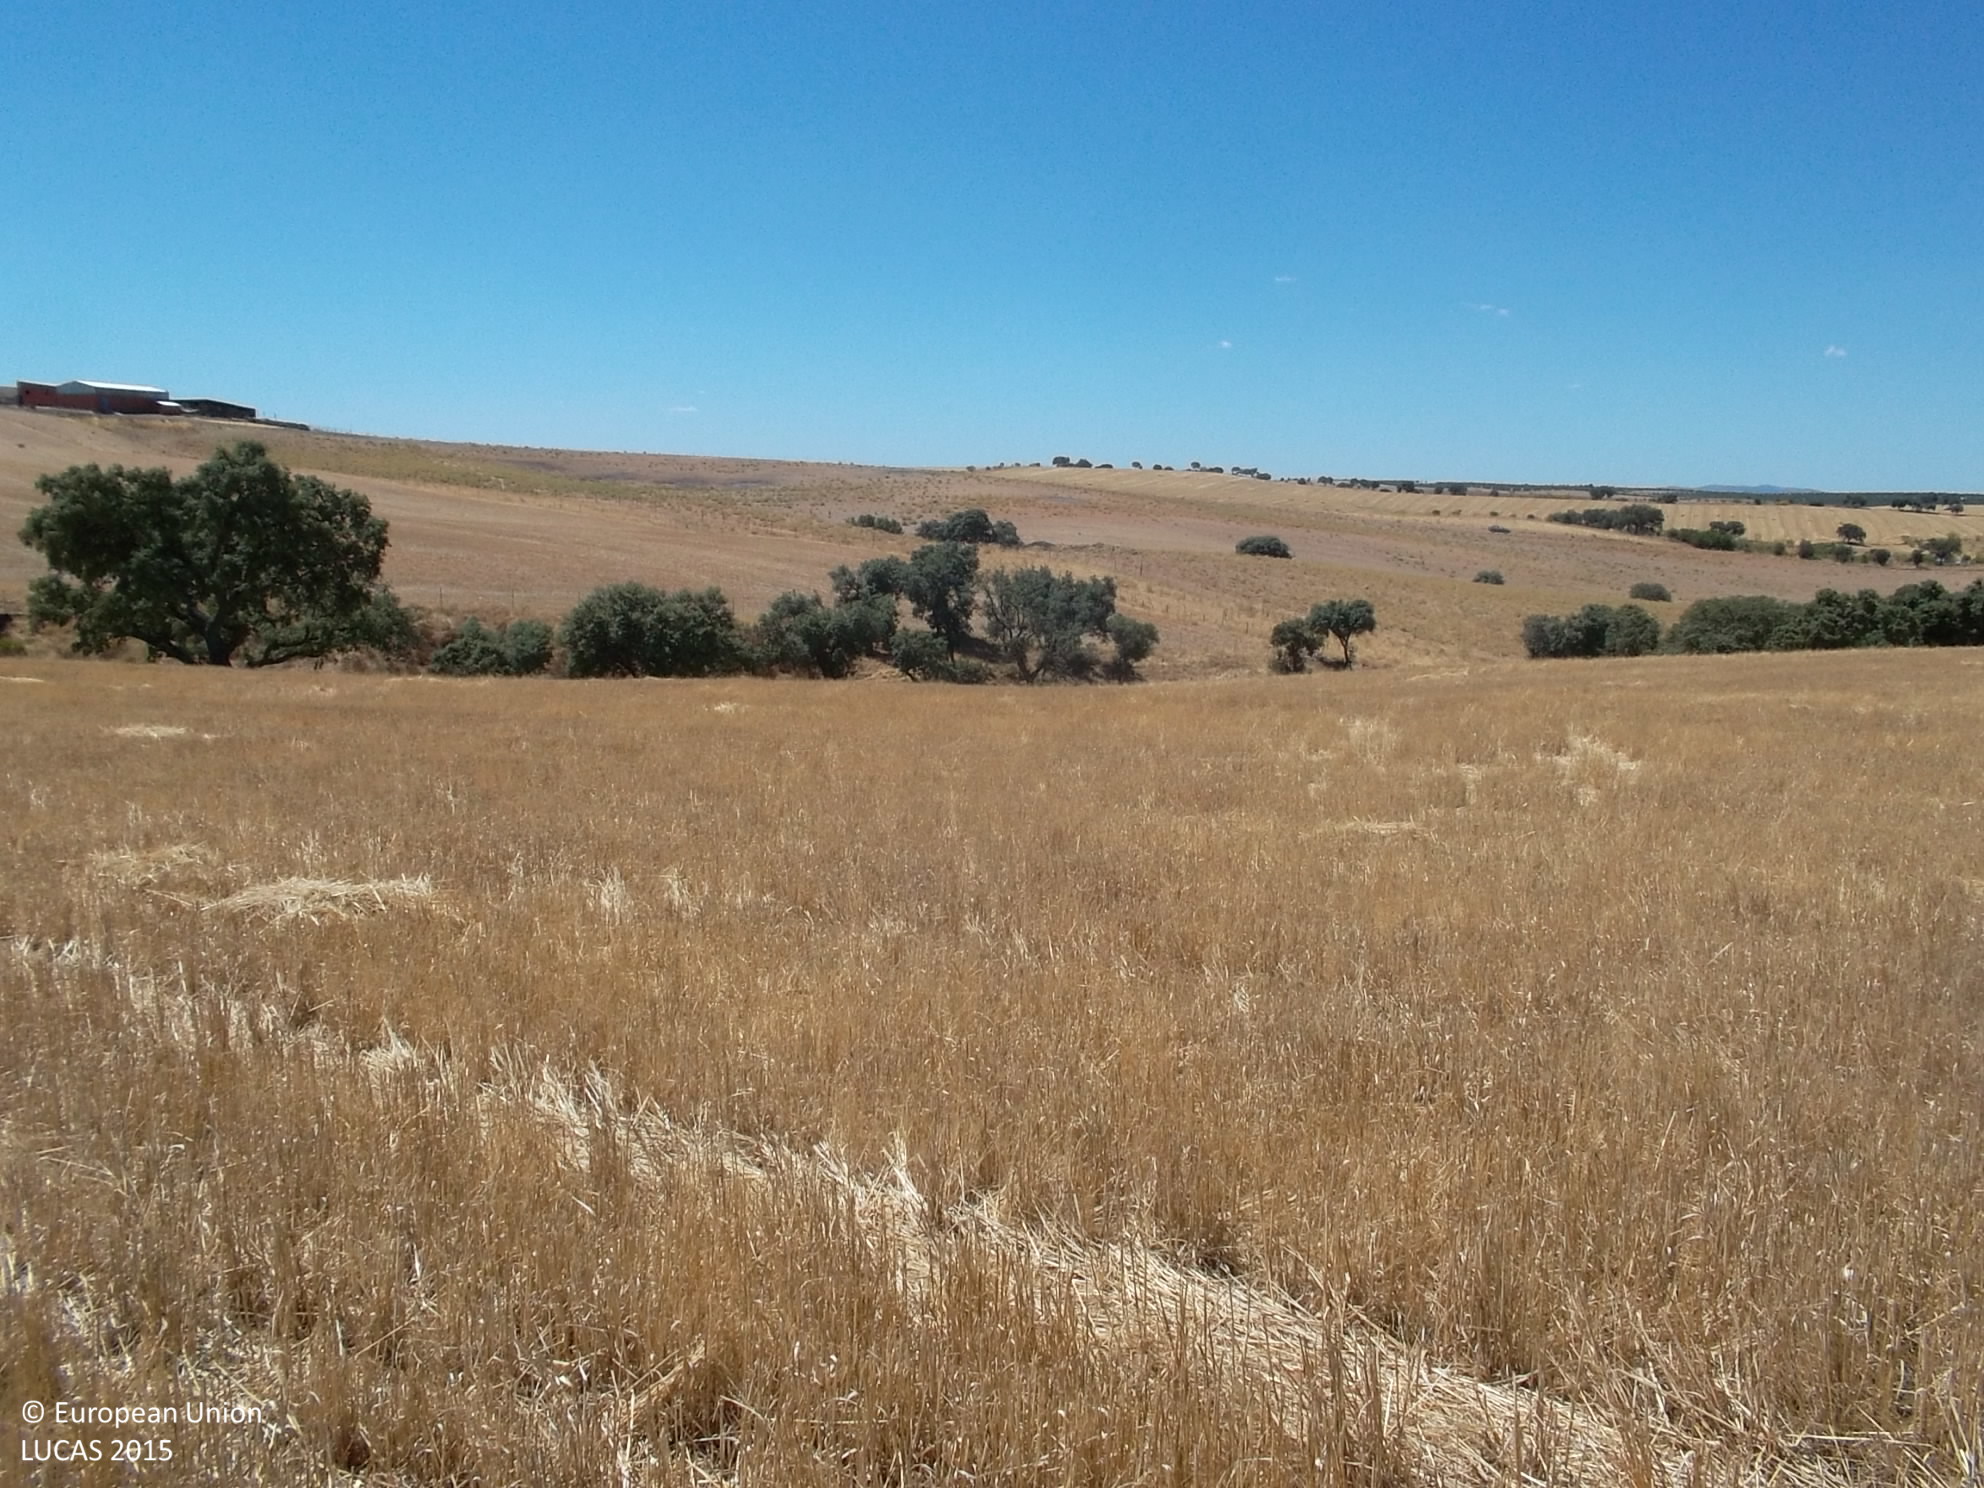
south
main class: Cropland
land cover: Oats
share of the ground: < 10 %
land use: Agriculture (excluding fallow land and kitchen gardens)
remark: Harvested field
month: July
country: ES
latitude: 38.4061
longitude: -5.8077
